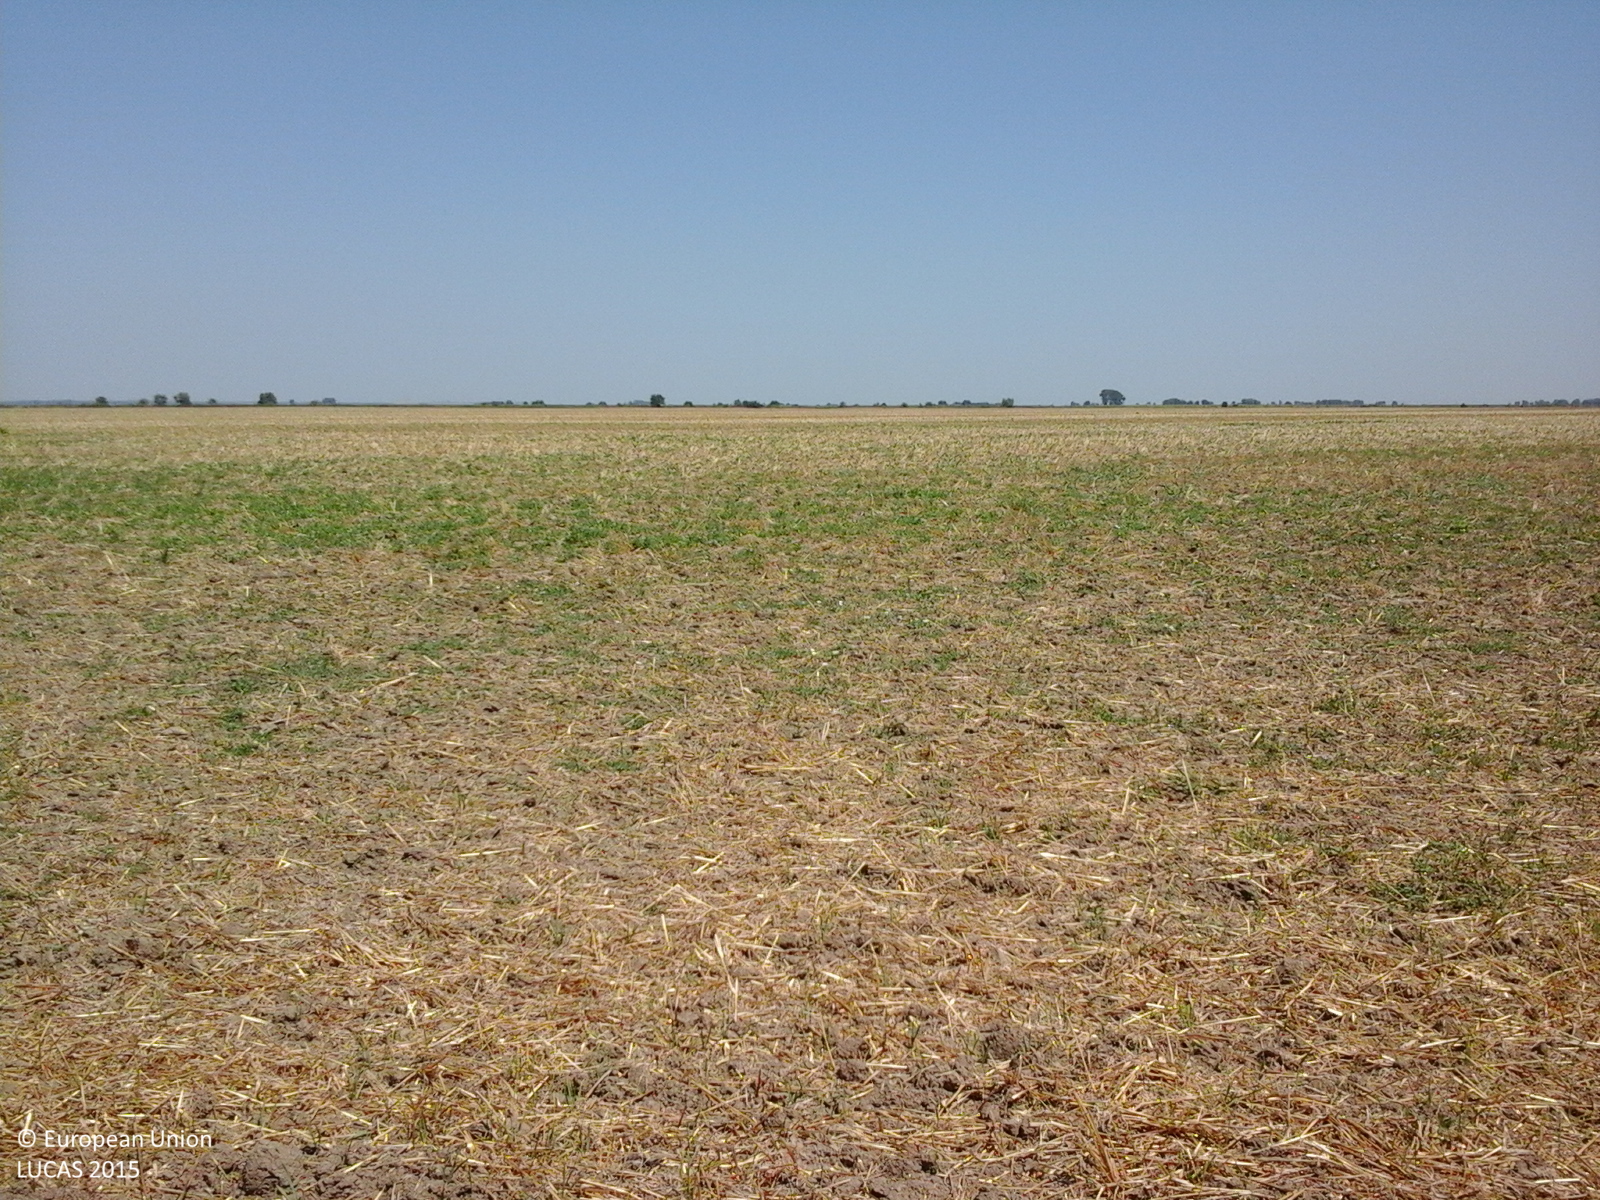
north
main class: Cropland
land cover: Durum wheat
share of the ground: < 10 %
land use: Agriculture (excluding fallow land and kitchen gardens)
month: July
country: RO
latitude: 44.2581
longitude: 27.8745
